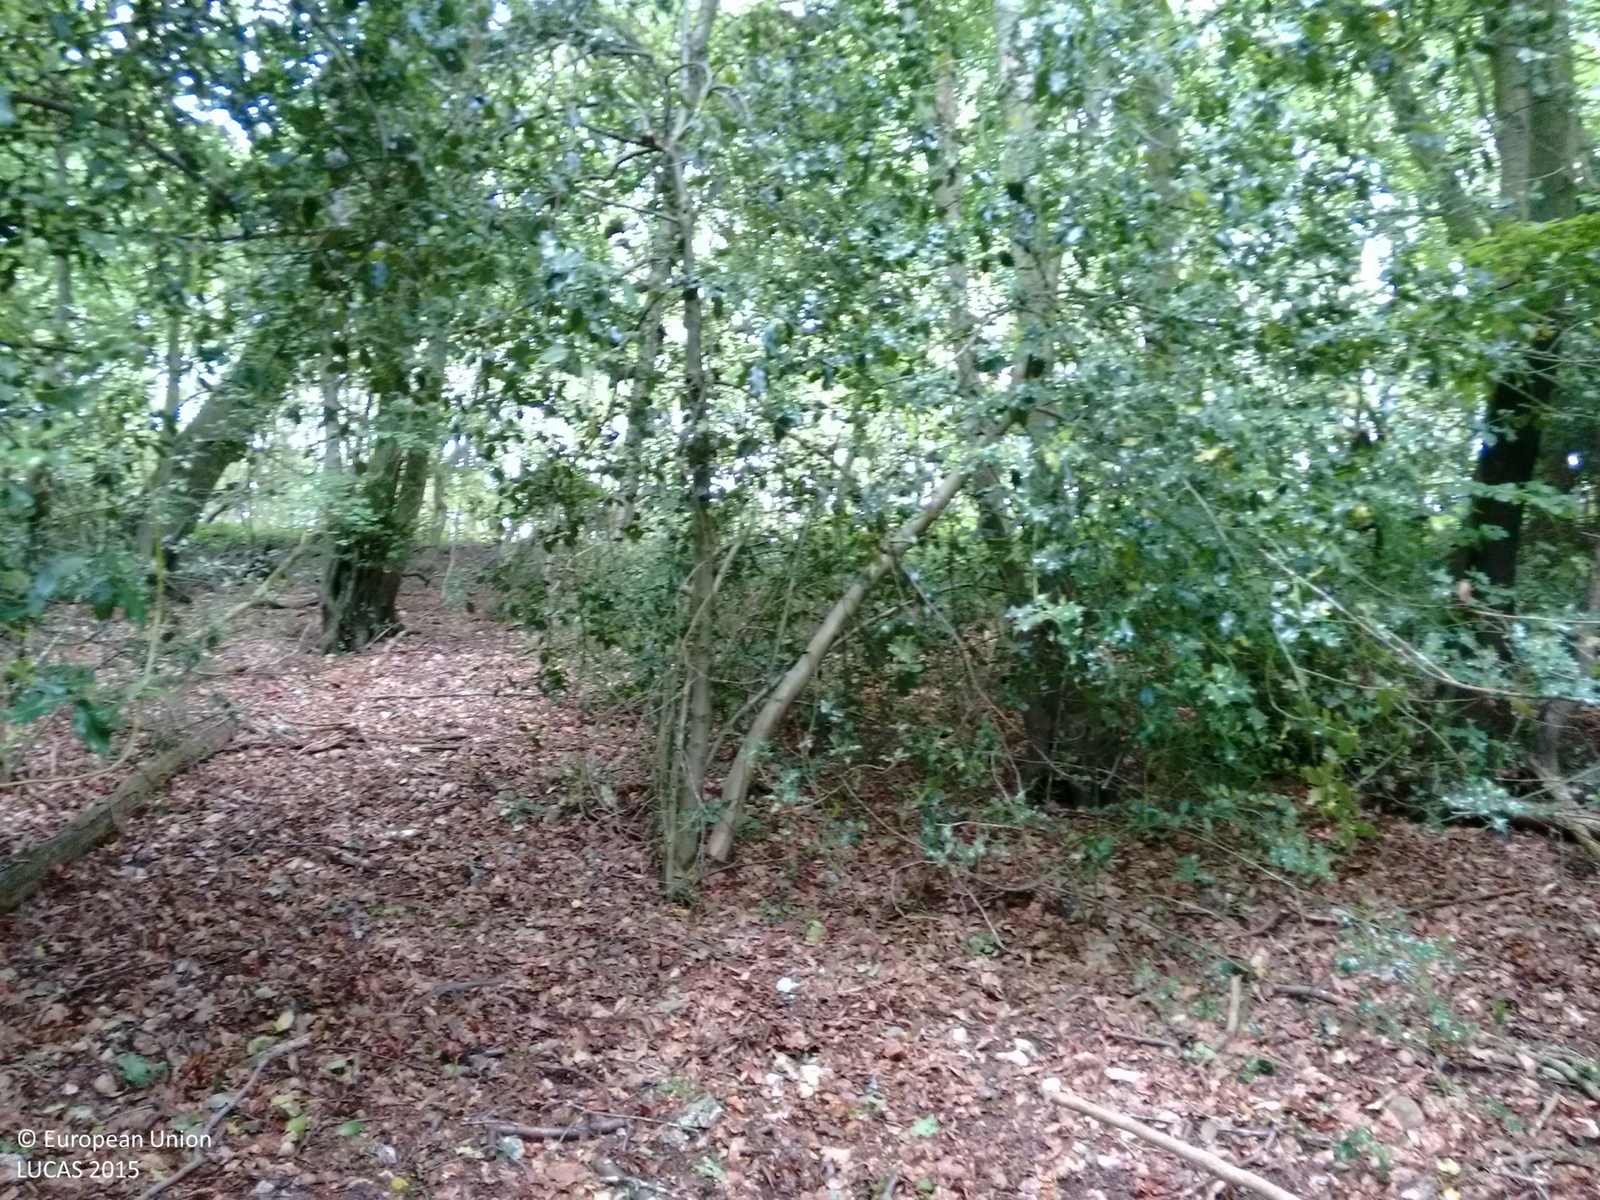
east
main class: Woodland
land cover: Broadleaved woodland
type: mesophytic deciduous forest
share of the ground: > 75 %
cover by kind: broadleaved forest trees 95 %, shrubs 5 %
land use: Semi-natural and natural areas not in use
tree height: > 5 m
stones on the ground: 25 - 50 %
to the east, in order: Broadleaved woodland; Tracks; Fences; Broadleaved woodland; Fences; Grass margins; Barley; Fences; Abandoned hedges; Grass margins; Barley; Grassland without tree/shrub cover
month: June
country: GB
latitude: 51.6873
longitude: -0.7601
